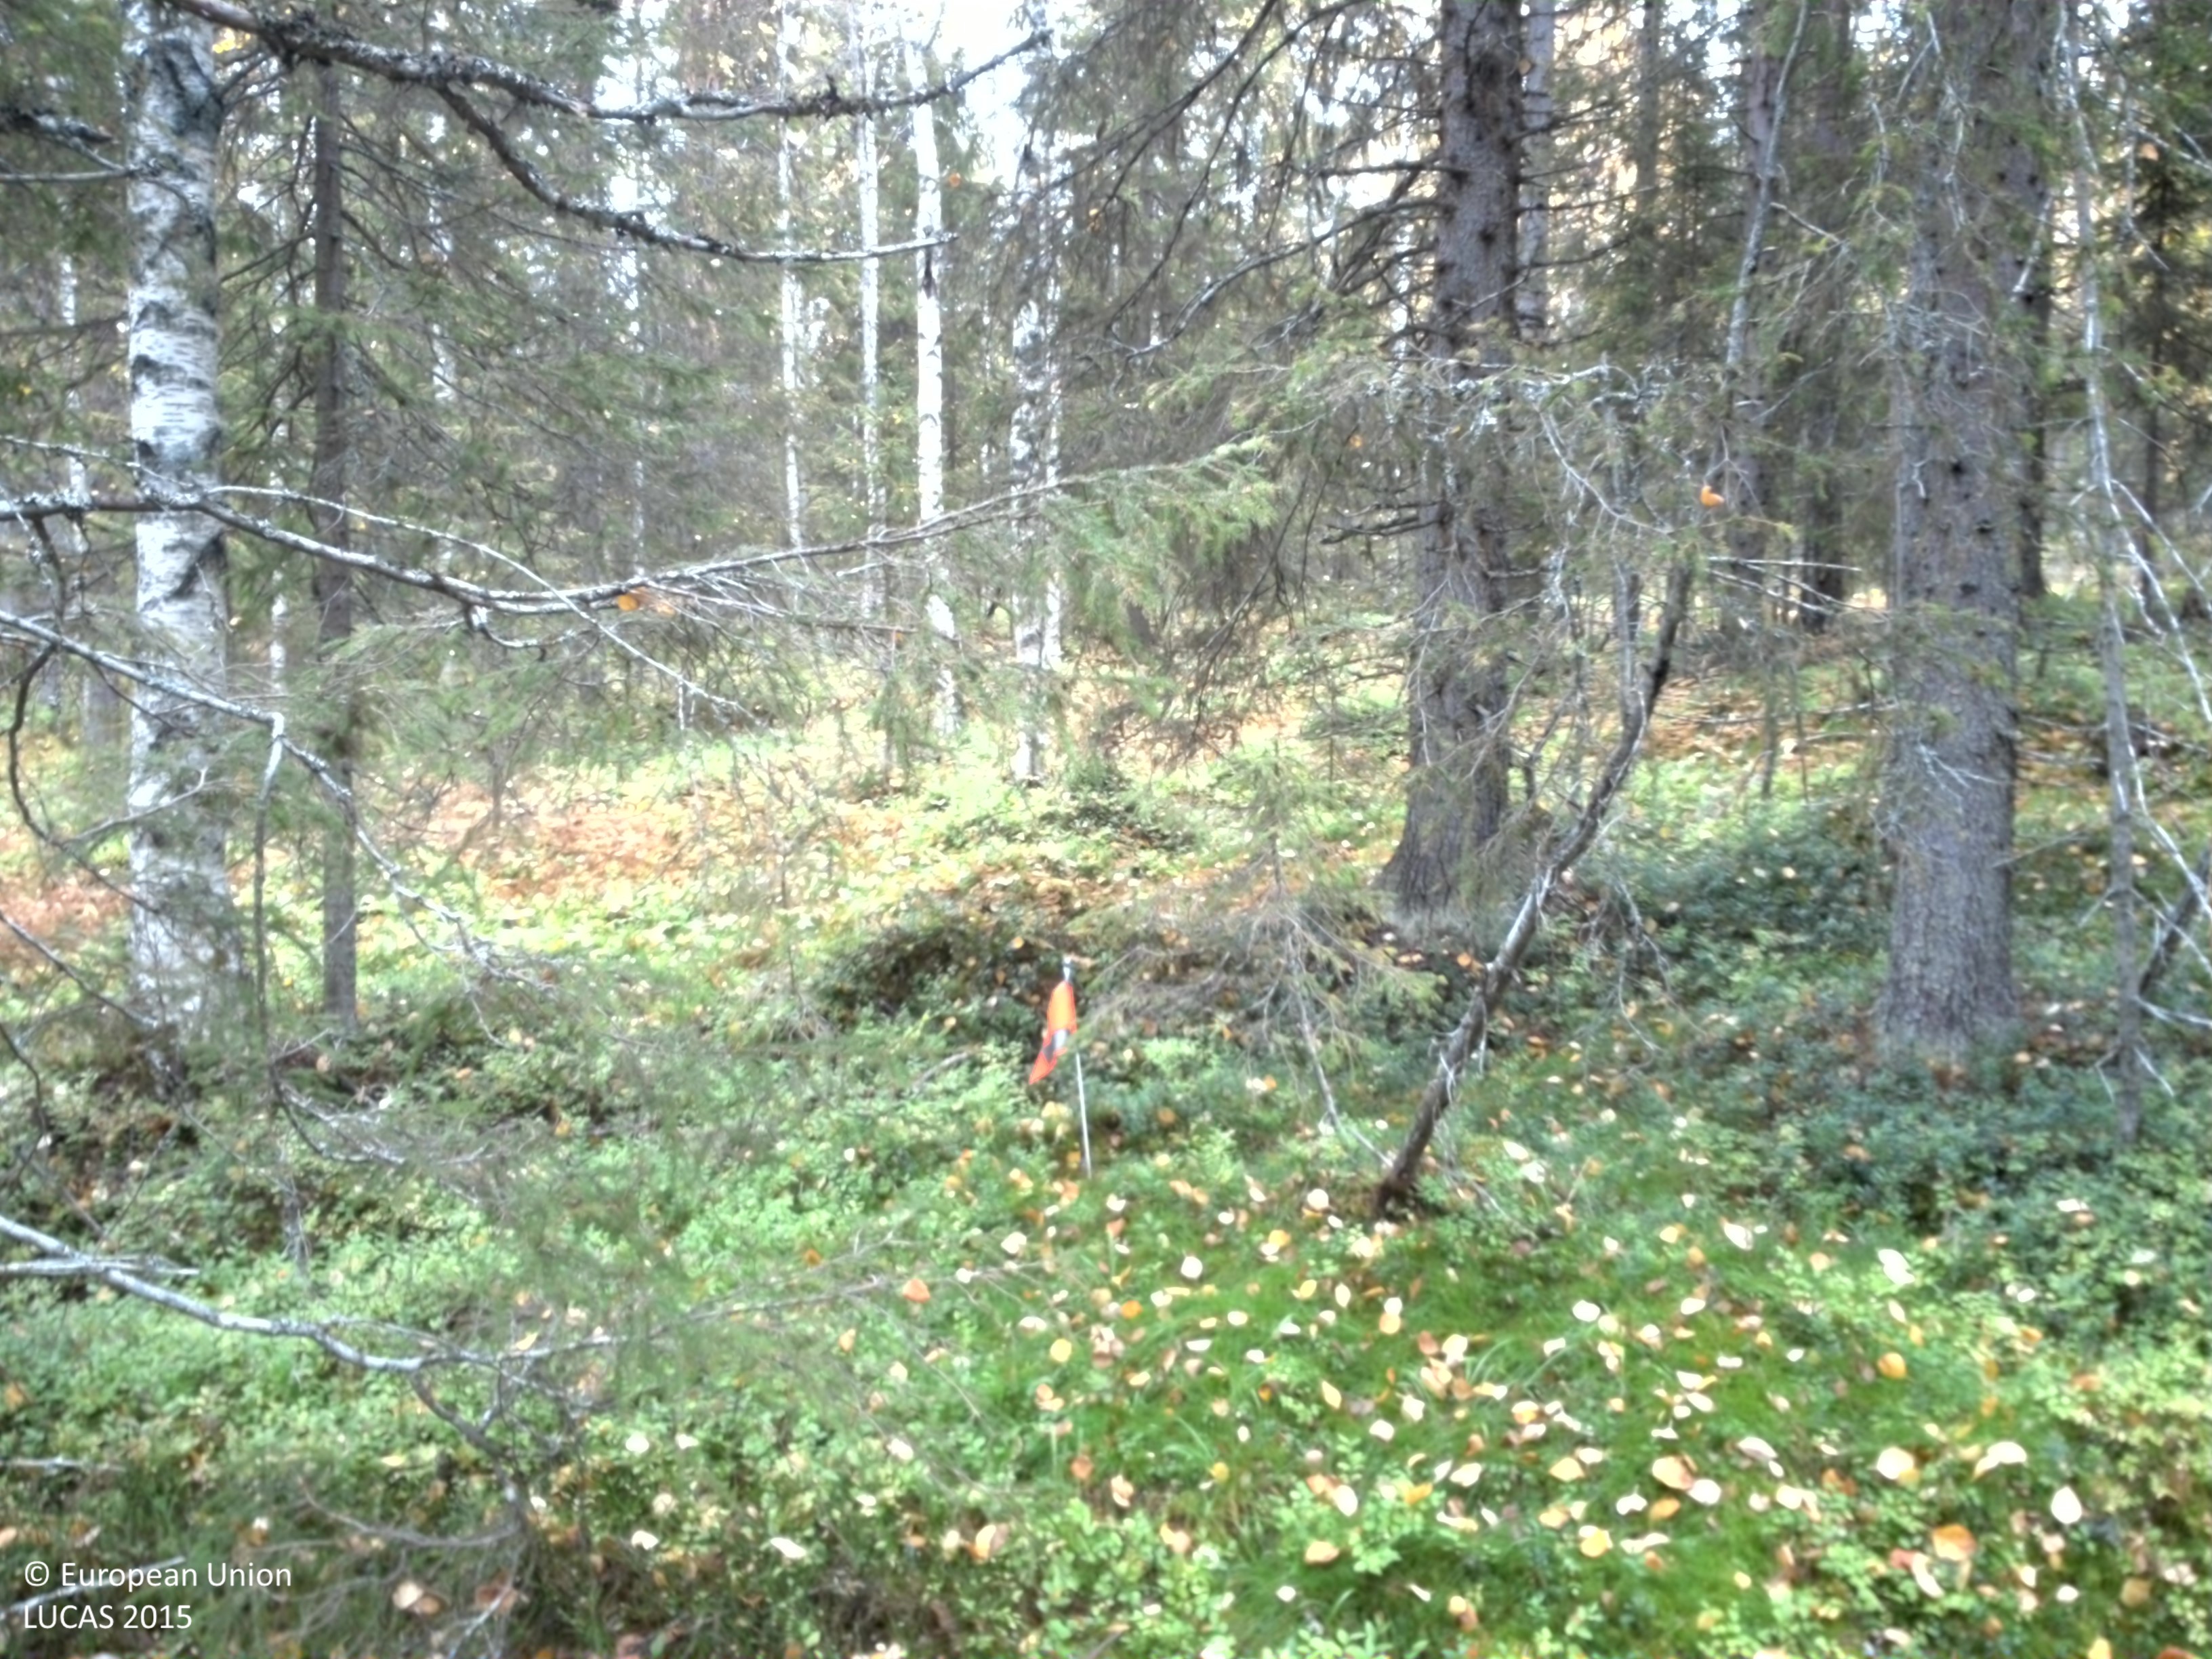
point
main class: Woodland
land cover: Spruce dominated mixed woodland
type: boreal forest
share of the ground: 50 - 75 %
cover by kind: coniferous forest trees 35 %, shrubs 20 %, herbaceous plants 20 %, broadleaved forest trees 15 %, lichens and mosses 10 %
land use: Forestry
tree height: > 5 m
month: September
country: SE
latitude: 65.1215
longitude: 17.6532
